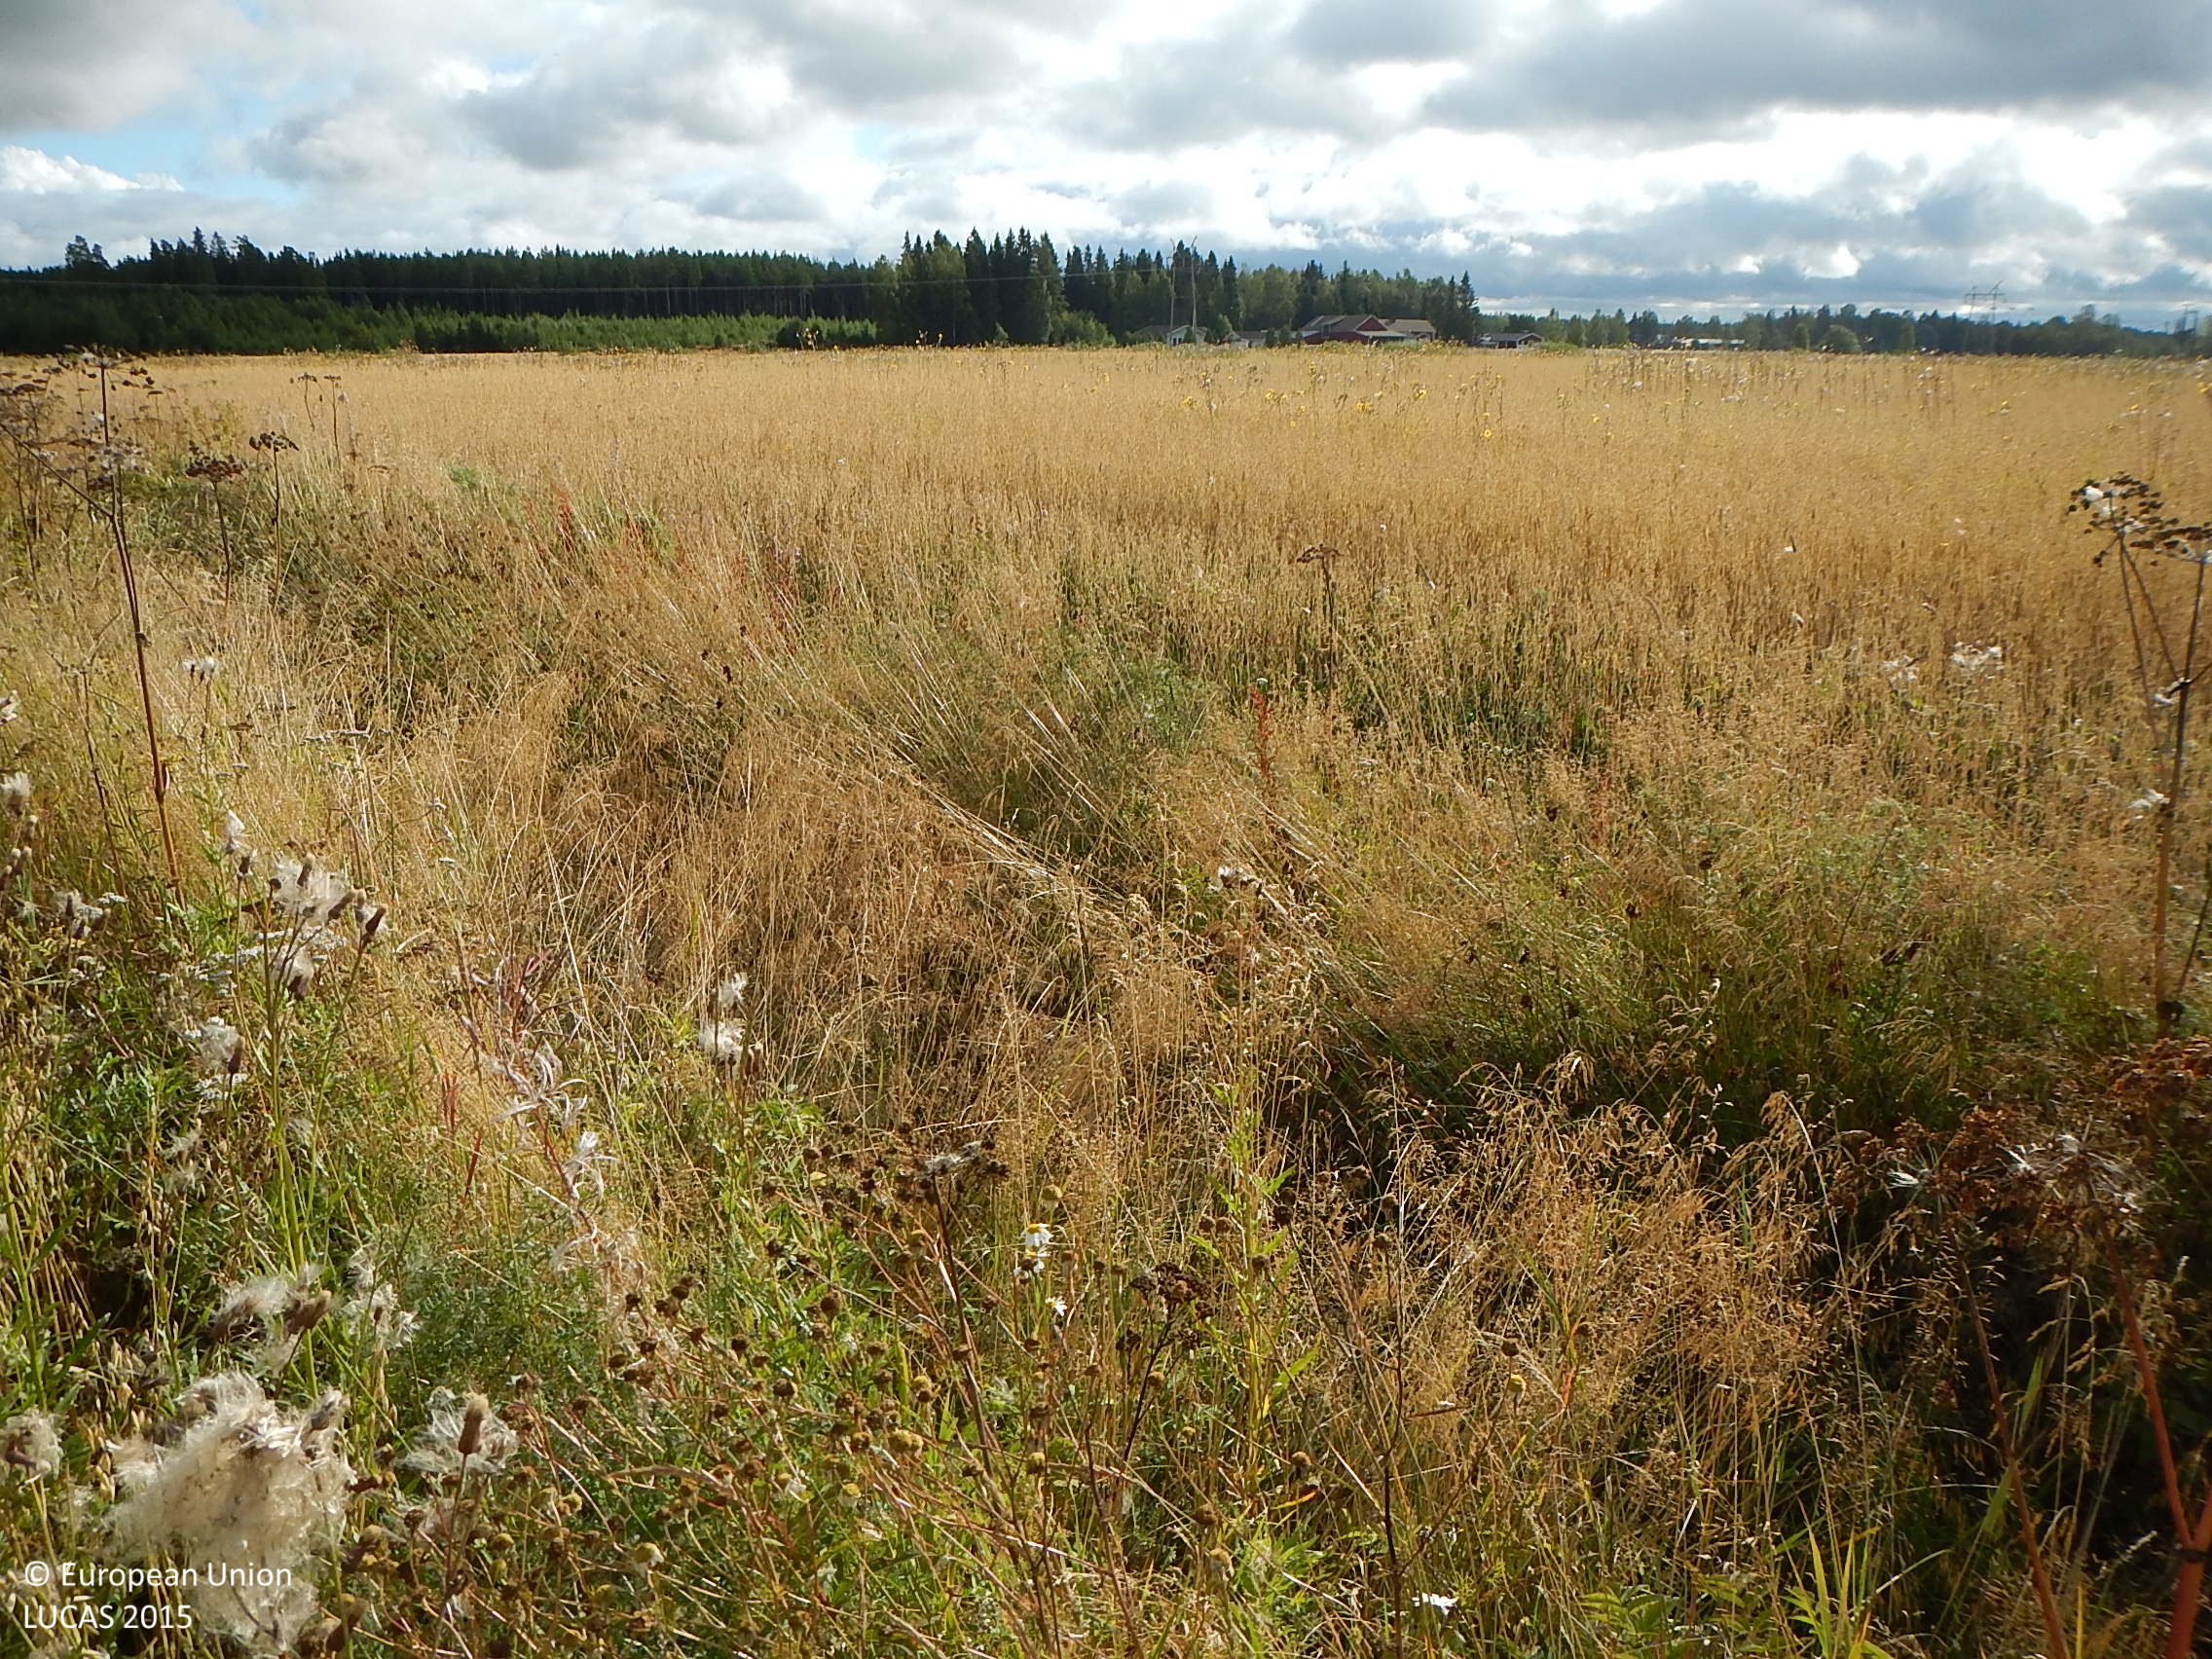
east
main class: Cropland
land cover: Oats
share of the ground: > 75 %
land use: Agriculture (excluding fallow land and kitchen gardens)
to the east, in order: Oats; Grass margins; Ditches and canals; Grass margins; Oats; Ditches and canals; Shruby margins; Grass margins; Paved roads, cycling and walking lanes; Grass margins; Oats
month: September
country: FI
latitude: 61.4156
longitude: 22.0299
